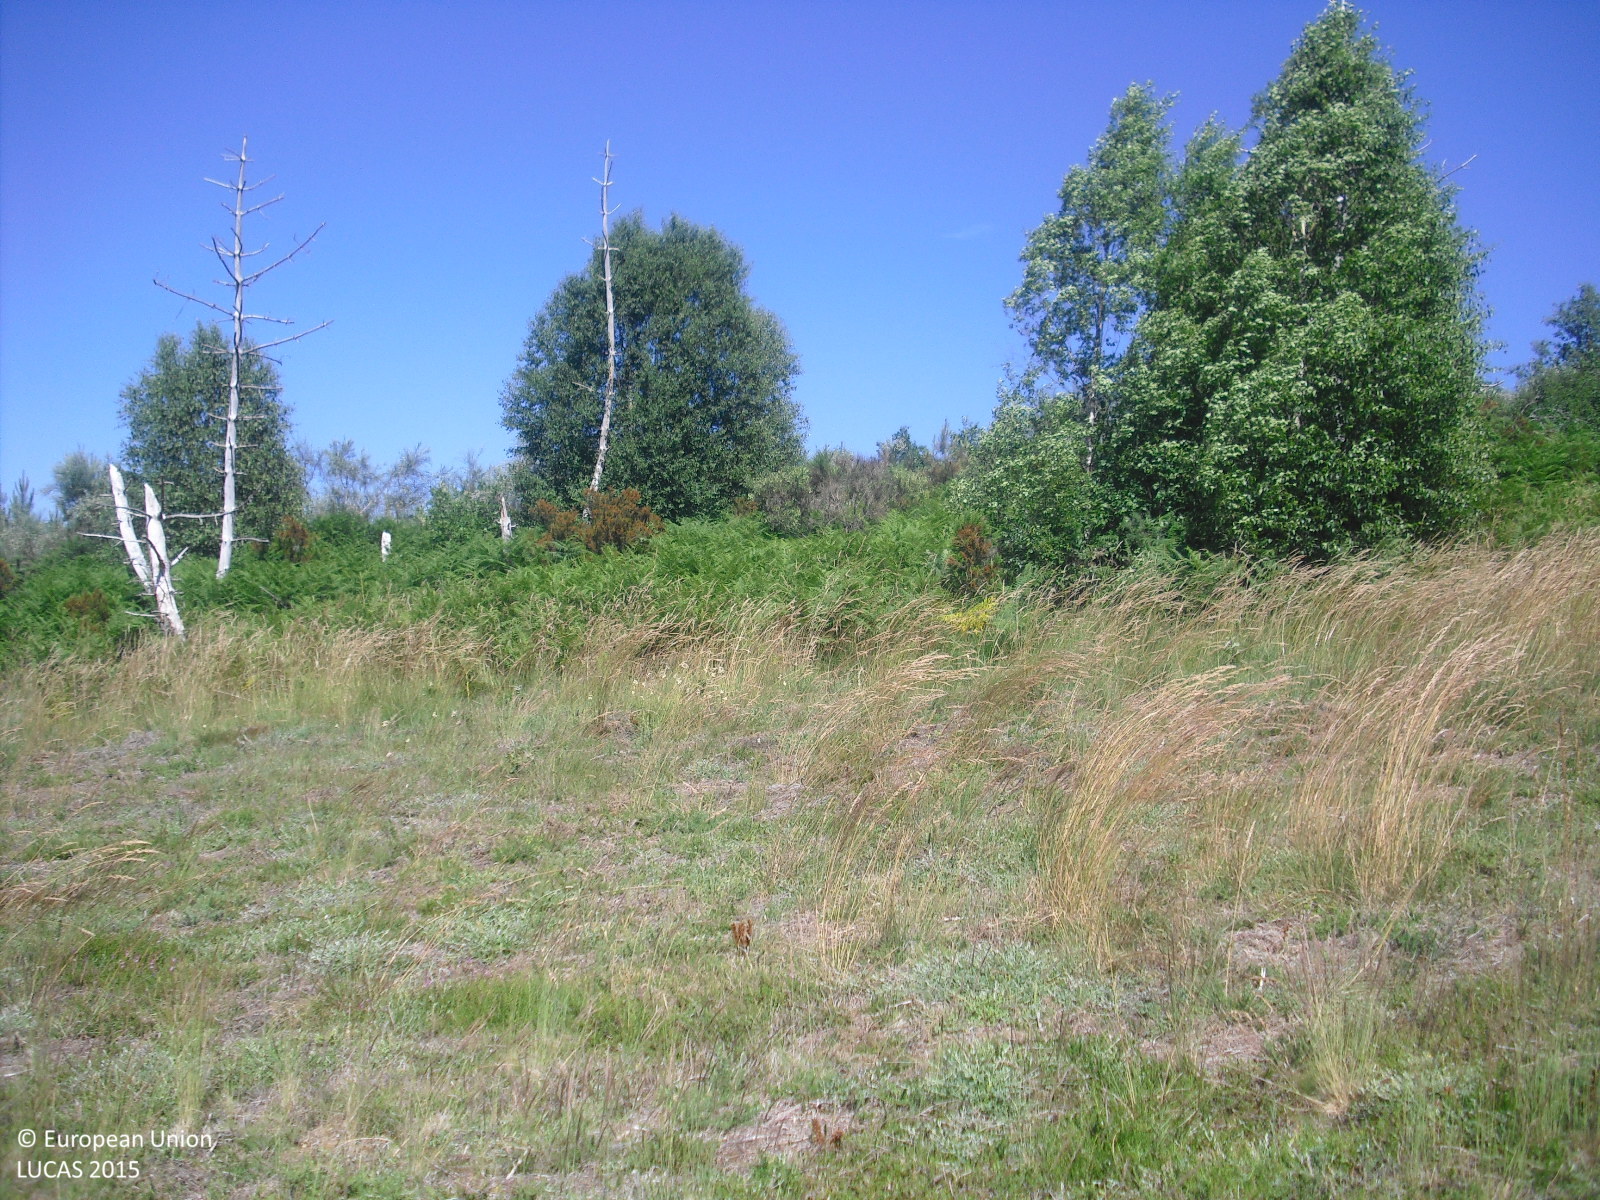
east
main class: Shrubland
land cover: Shrubland without tree cover
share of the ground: > 75 %
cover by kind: shrubs 70 %, herbaceous plants 30 %
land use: Semi-natural and natural areas not in use
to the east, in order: Shrubland without tree cover; Single bushes/trees; Shrubland without tree cover; Dry stone walls; Shrubland with sparse tree cover; Tracks; Shrubland without tree cover; Shrubland with sparse tree cover; Tracks; Ditches and canals; Shrubland without tree cover; Pine dominated mixed woodland; Broadleaved woodland
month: June
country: ES
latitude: 42.5878
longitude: -7.9344
